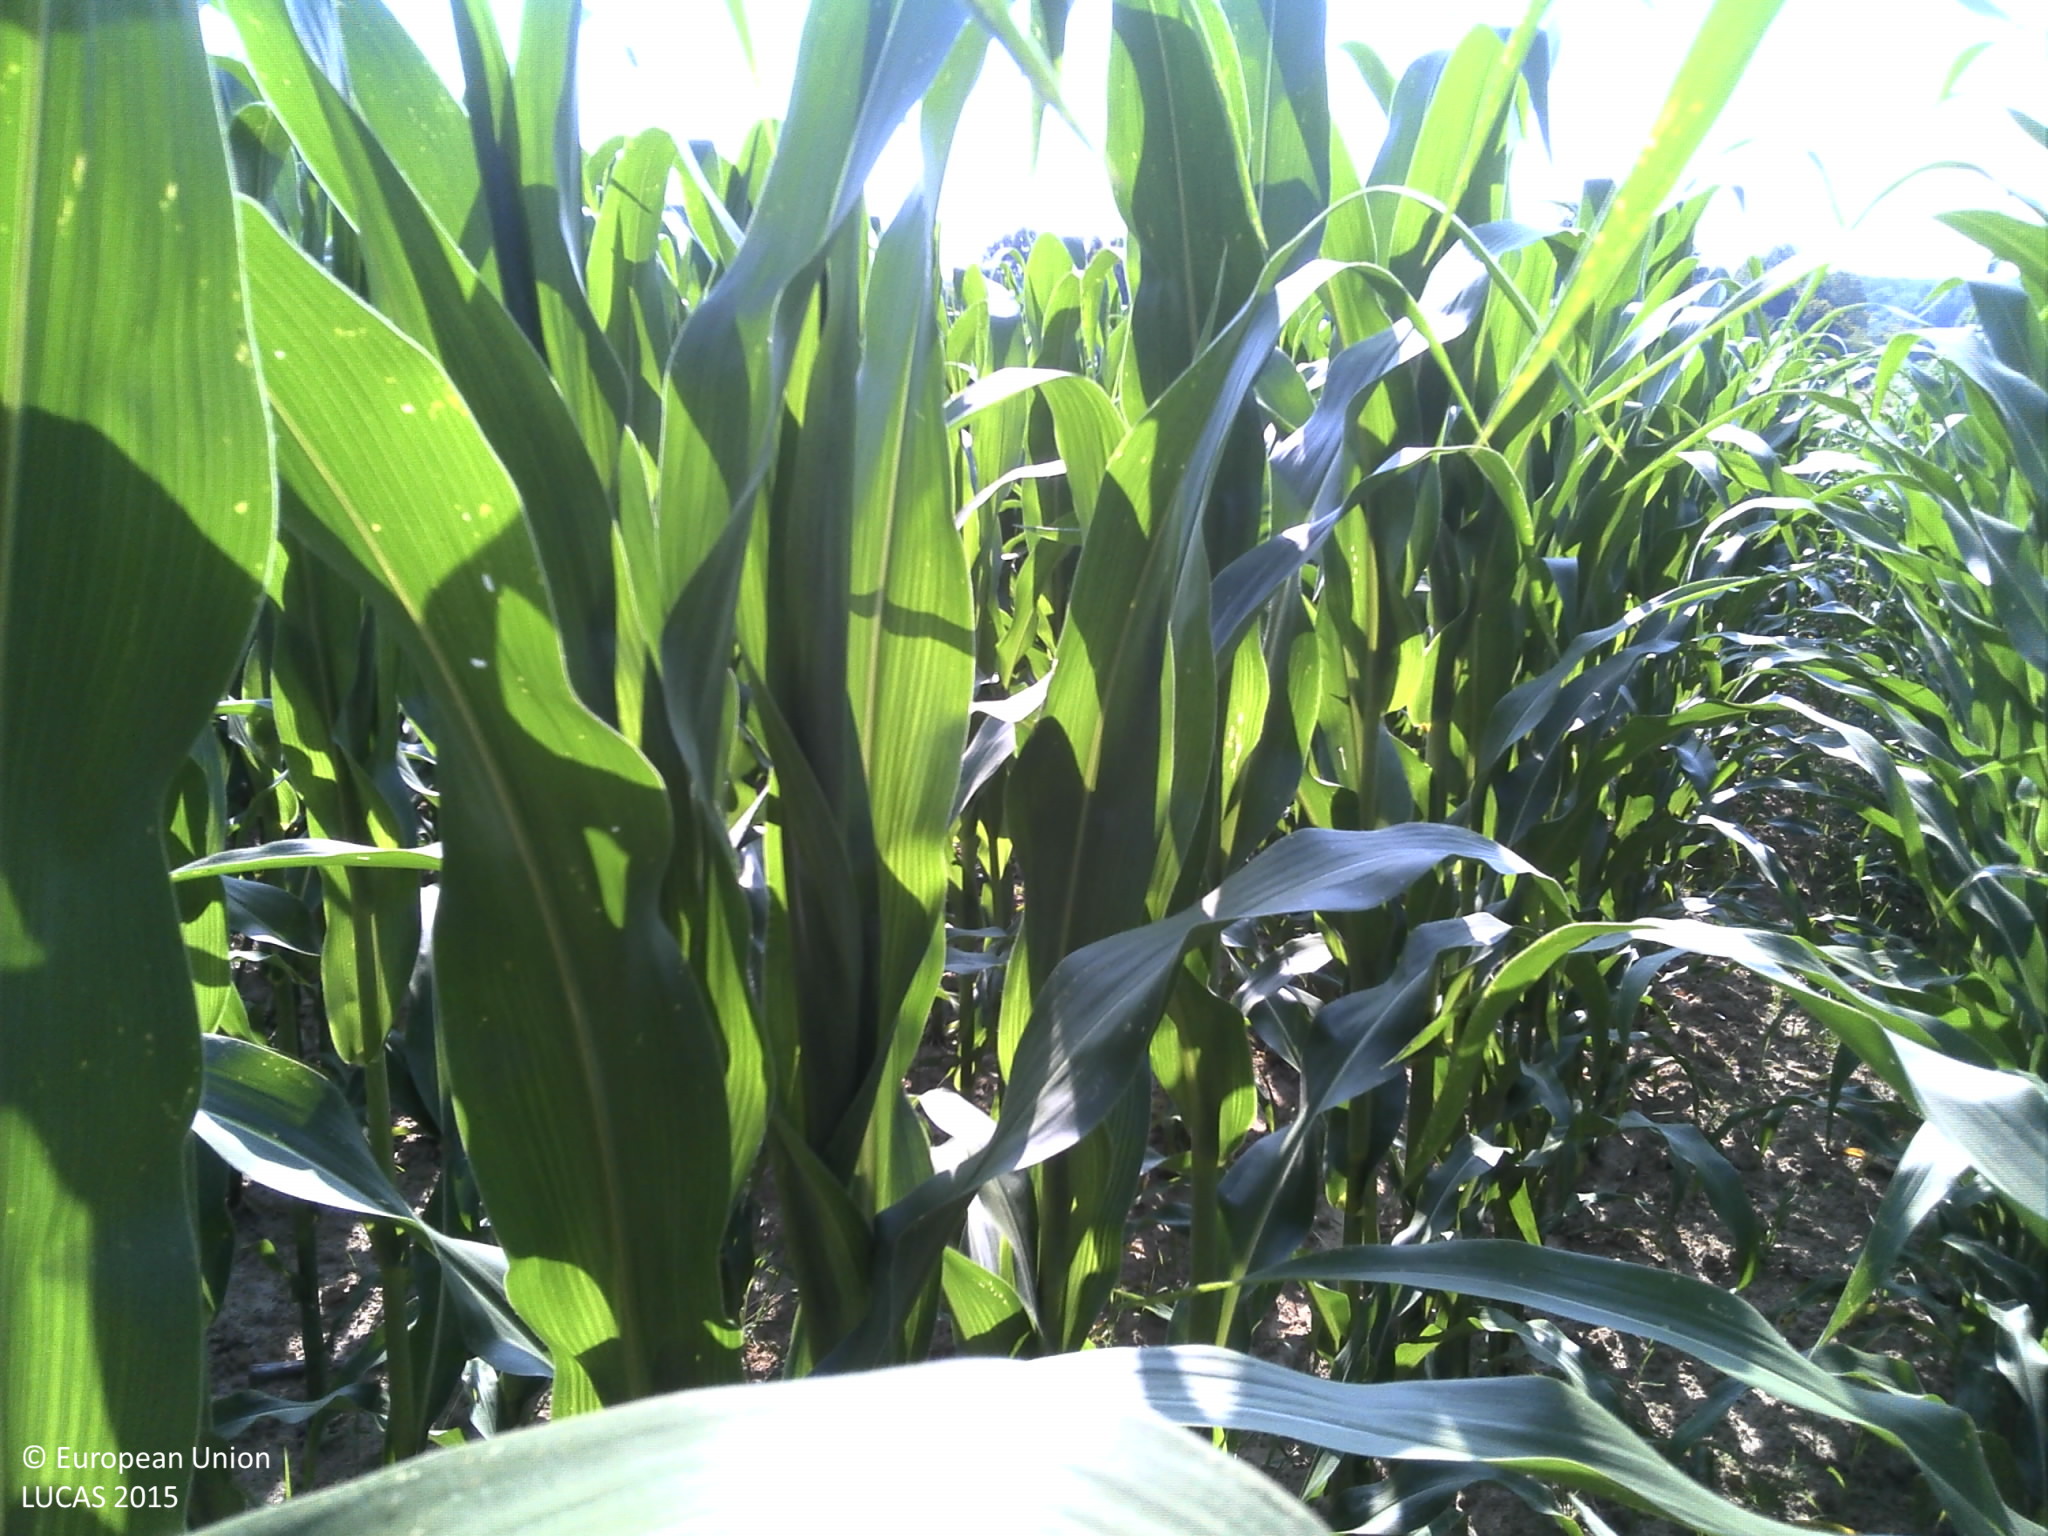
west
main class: Cropland
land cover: Maize
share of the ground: > 75 %
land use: Agriculture (excluding fallow land and kitchen gardens)
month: July
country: HR
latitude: 45.8007
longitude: 16.6514
